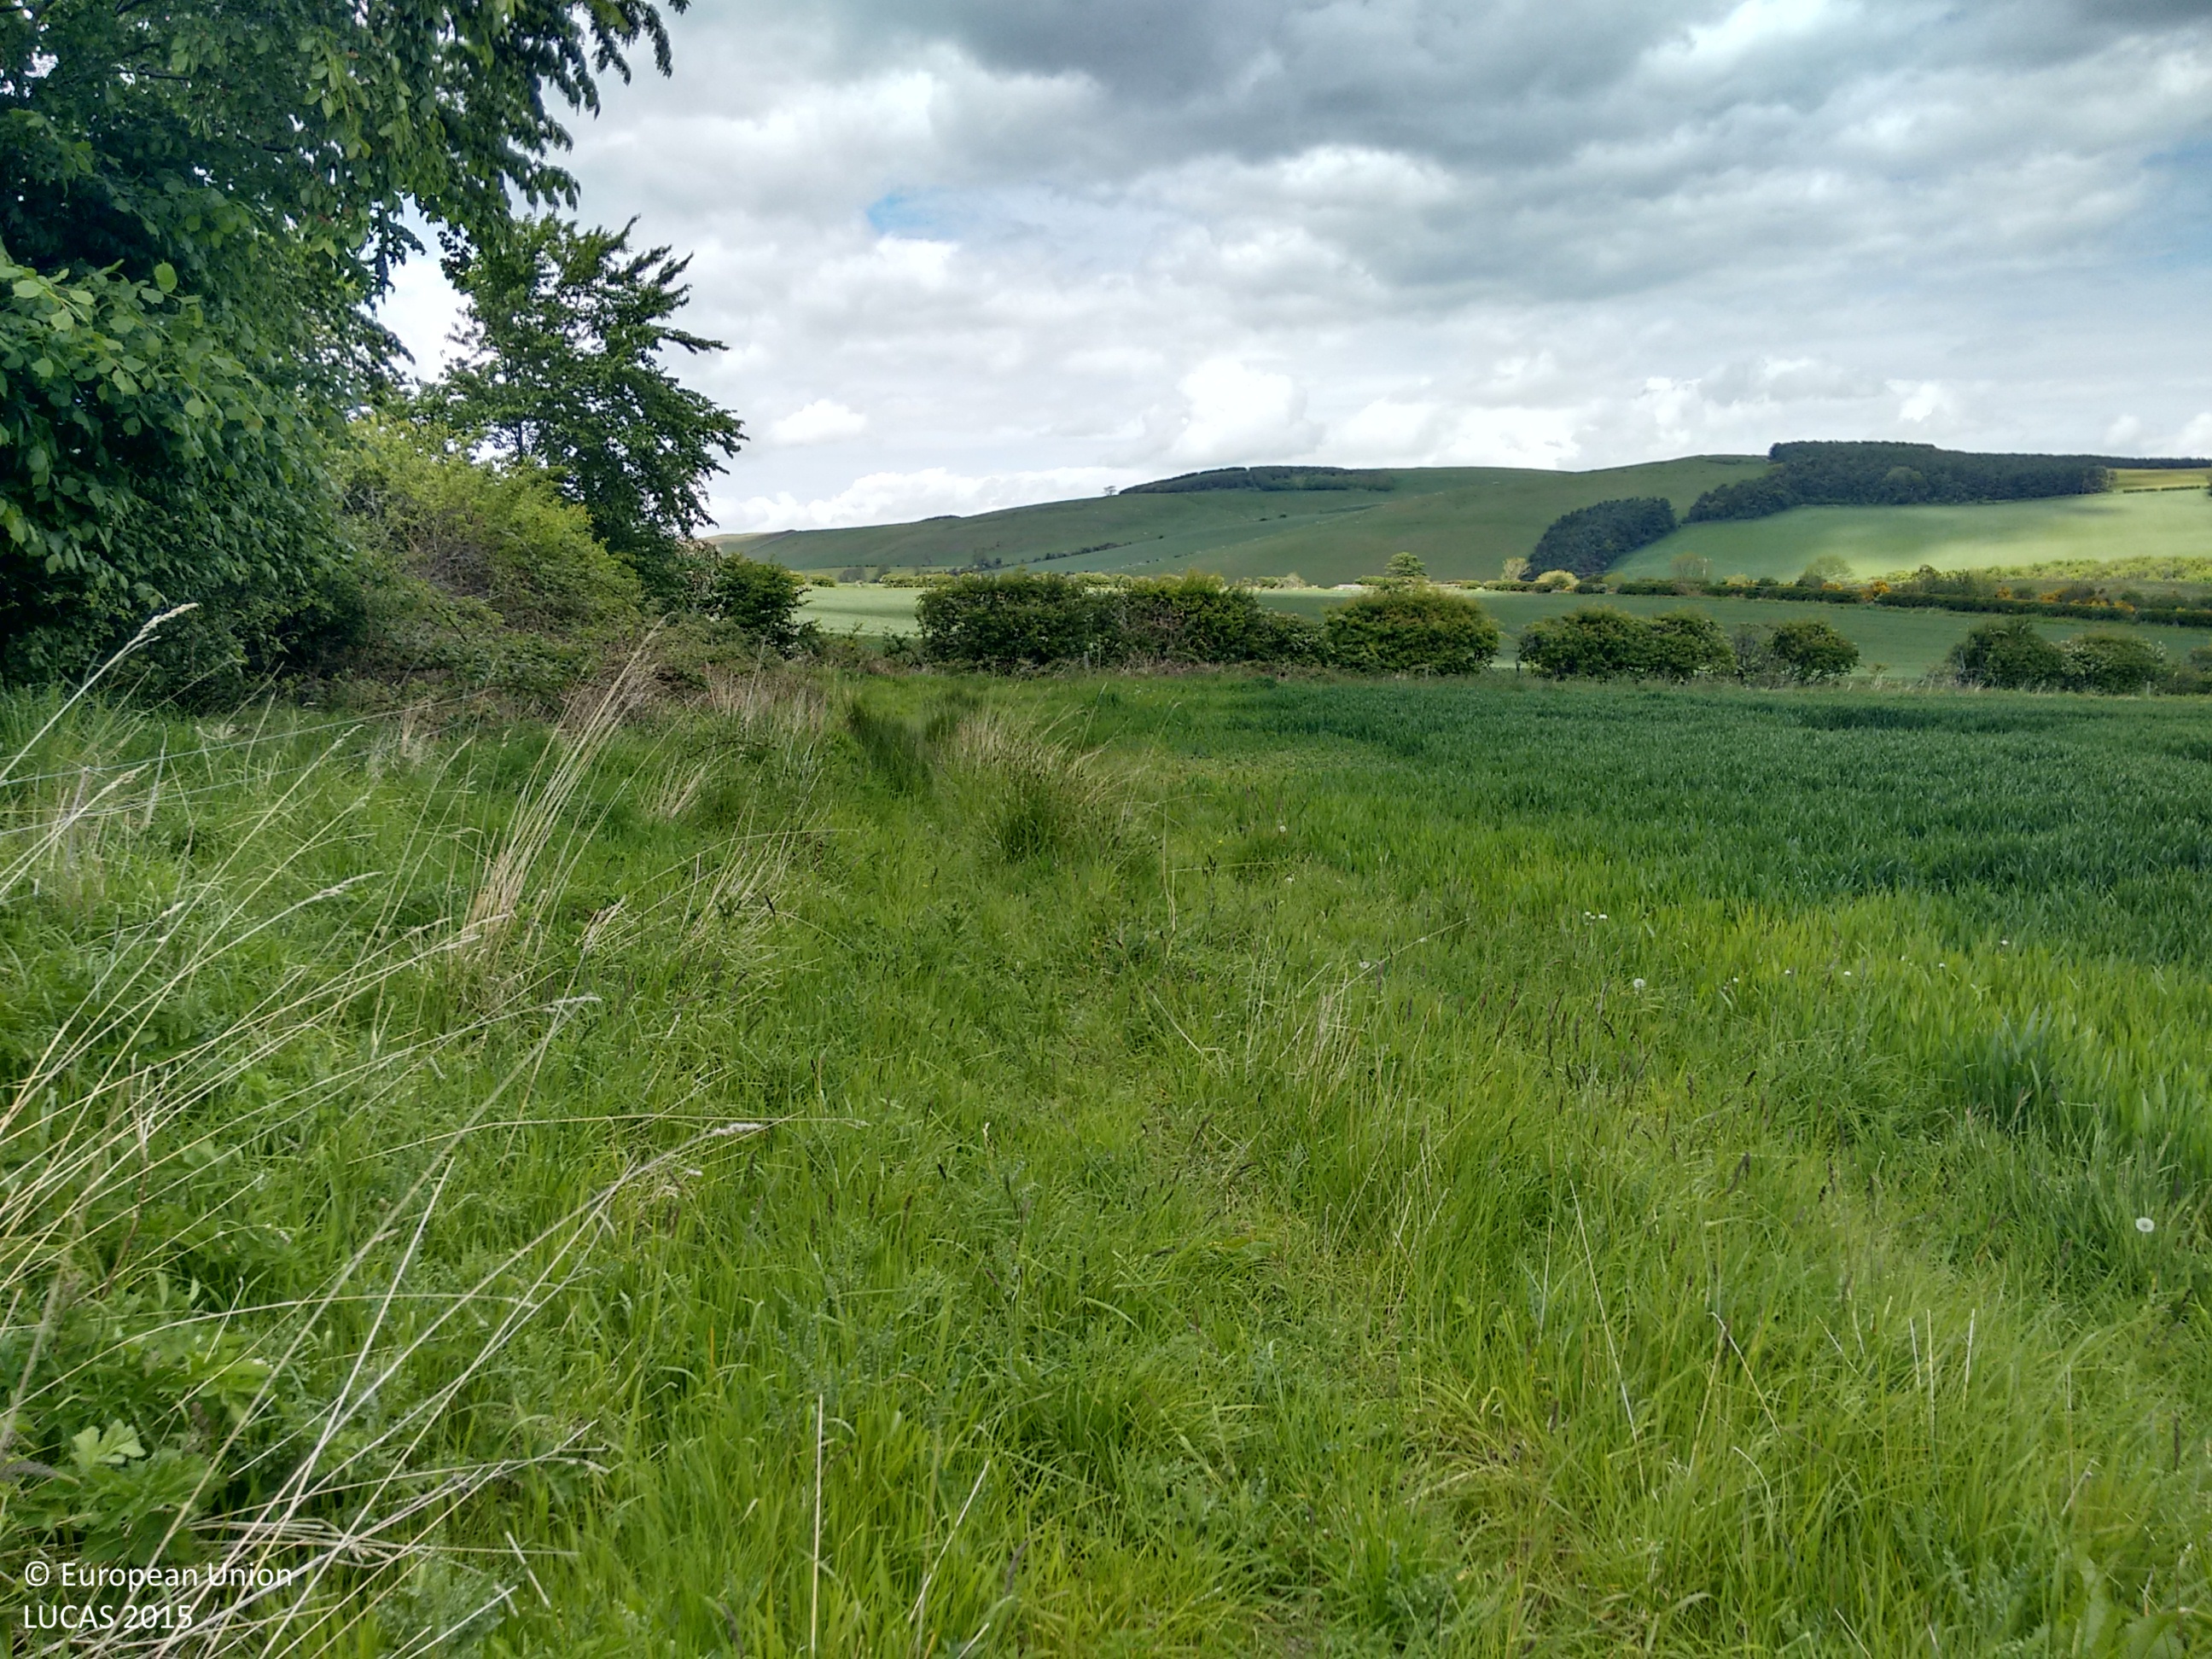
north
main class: Cropland
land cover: Barley
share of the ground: > 75 %
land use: Agriculture (excluding fallow land and kitchen gardens)
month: June
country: GB
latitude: 55.5855
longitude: -2.1926
